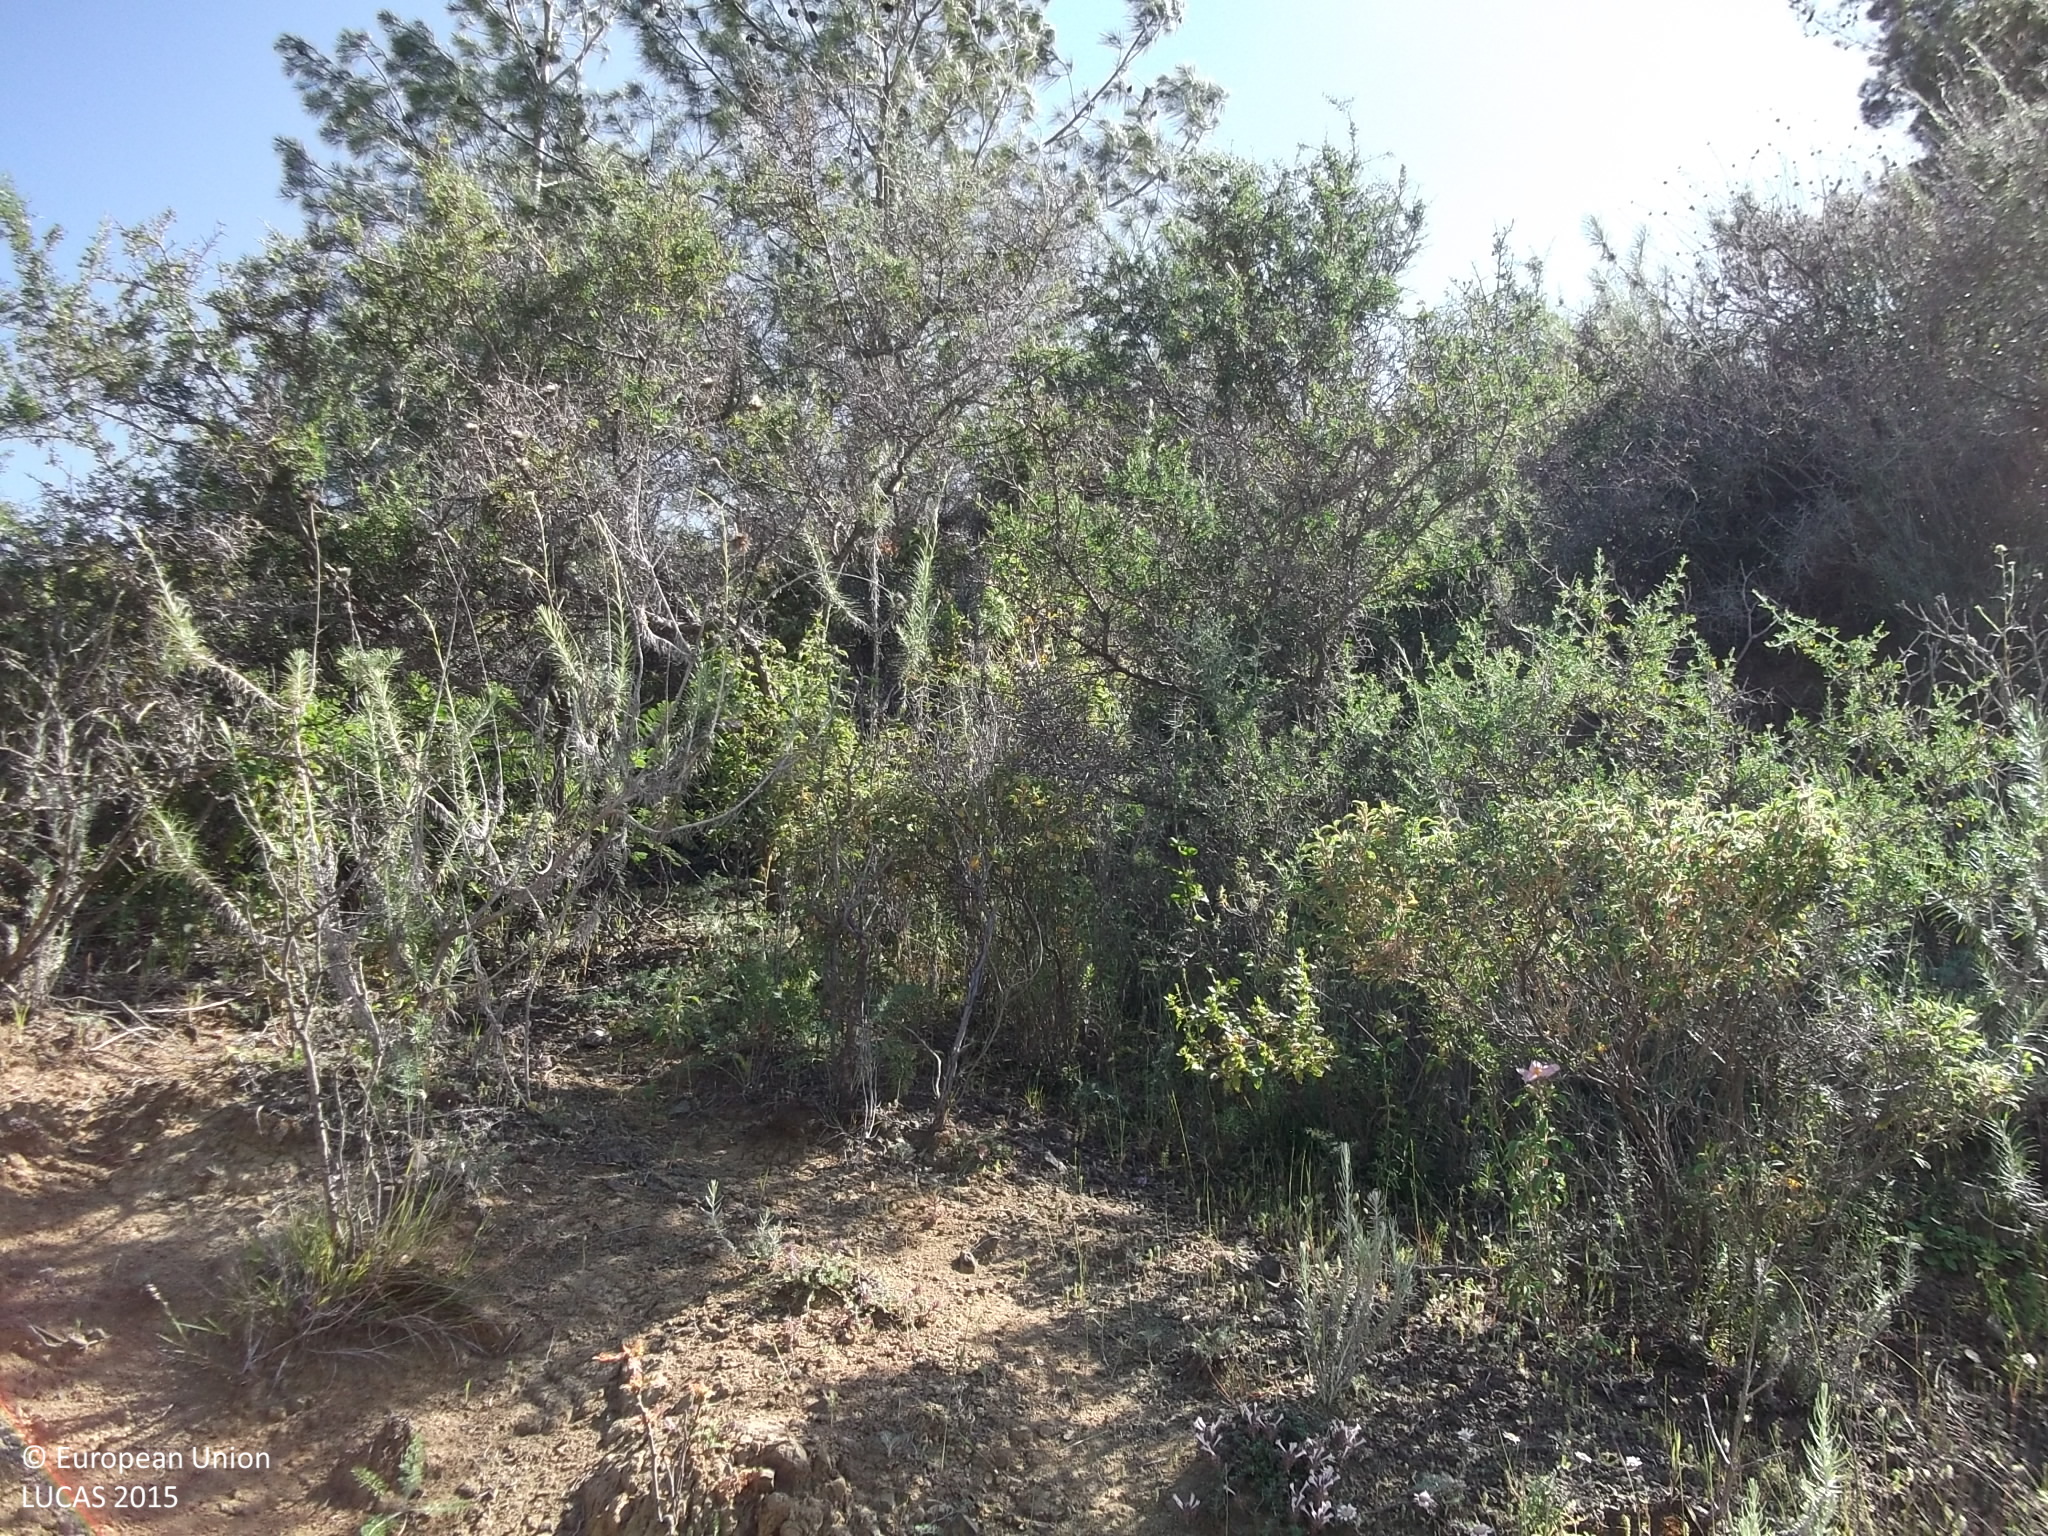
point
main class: Shrubland
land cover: Shrubland with sparse tree cover
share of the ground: > 75 %
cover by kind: shrubs 85 %, unconsolidated bare surface 10 %, coniferous forest trees 5 %
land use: Semi-natural and natural areas not in use
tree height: > 5 m
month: April
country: CY
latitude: 34.8421
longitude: 33.1050
